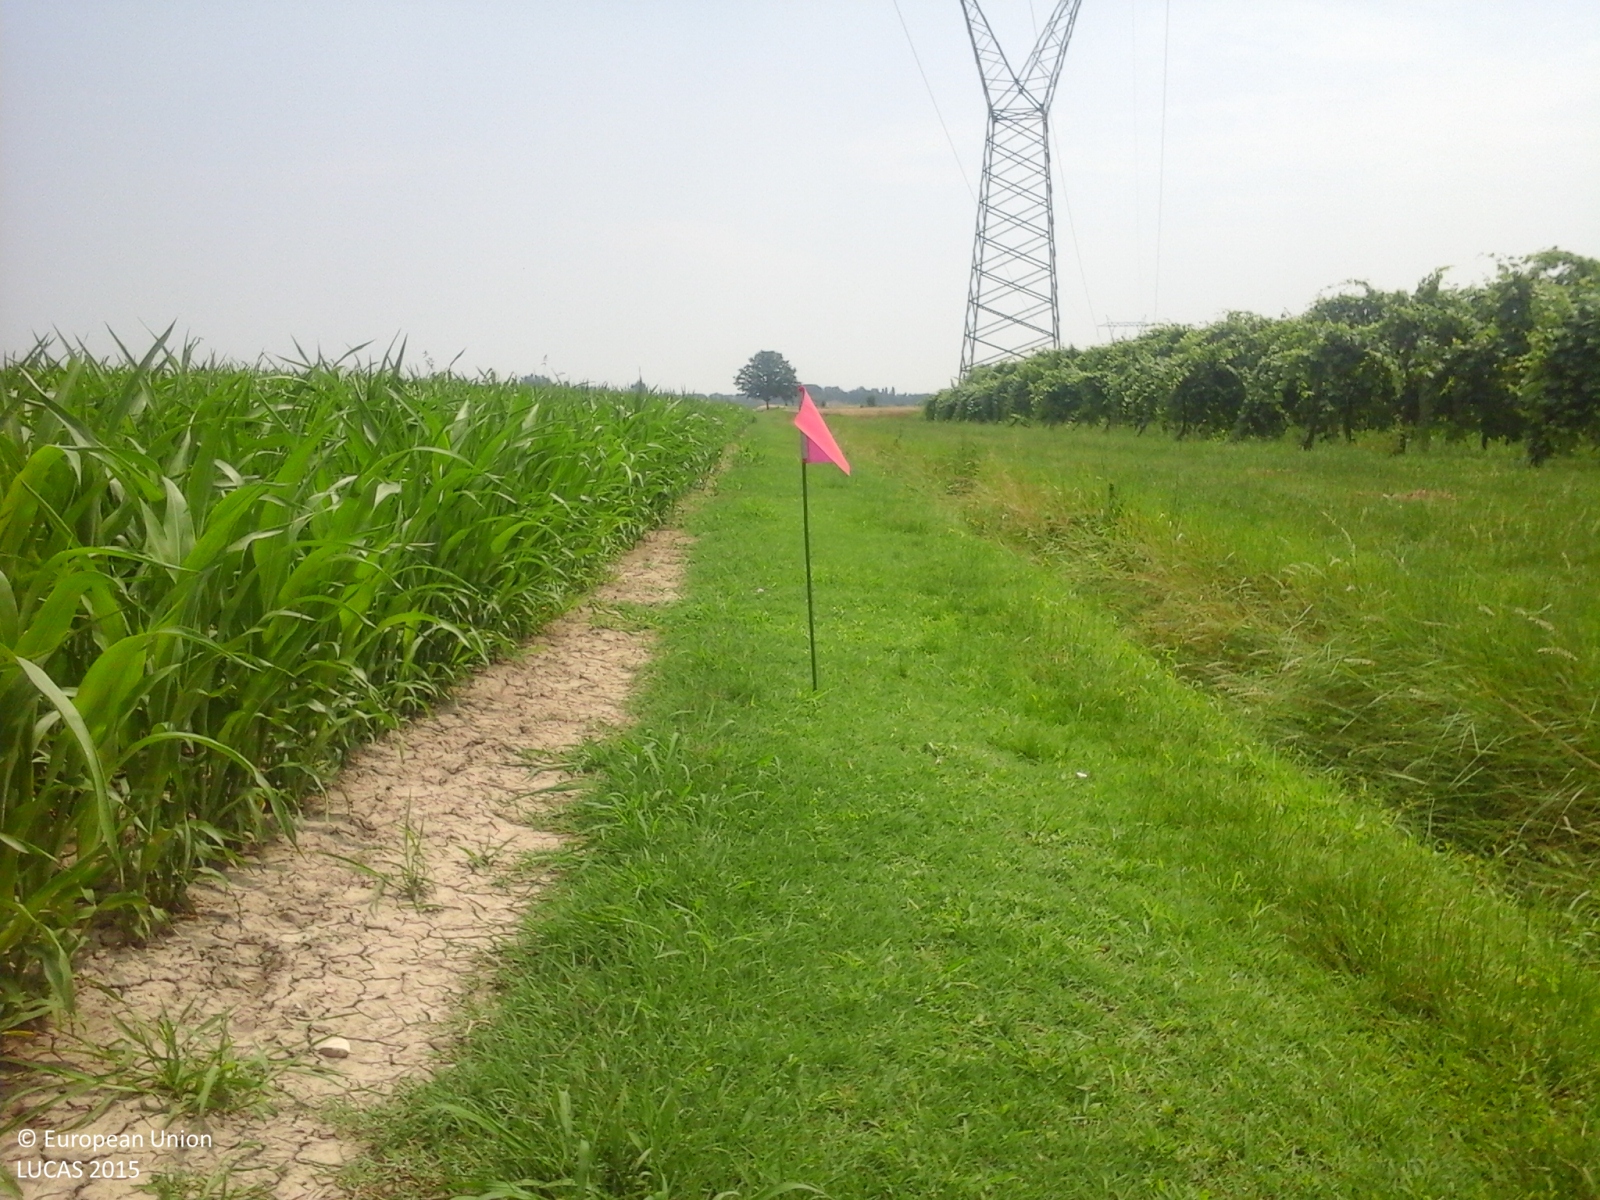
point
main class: Cropland
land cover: Other cereals
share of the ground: > 75 %
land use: Agriculture (excluding fallow land and kitchen gardens)
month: June
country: IT
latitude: 44.7596
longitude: 11.0968
